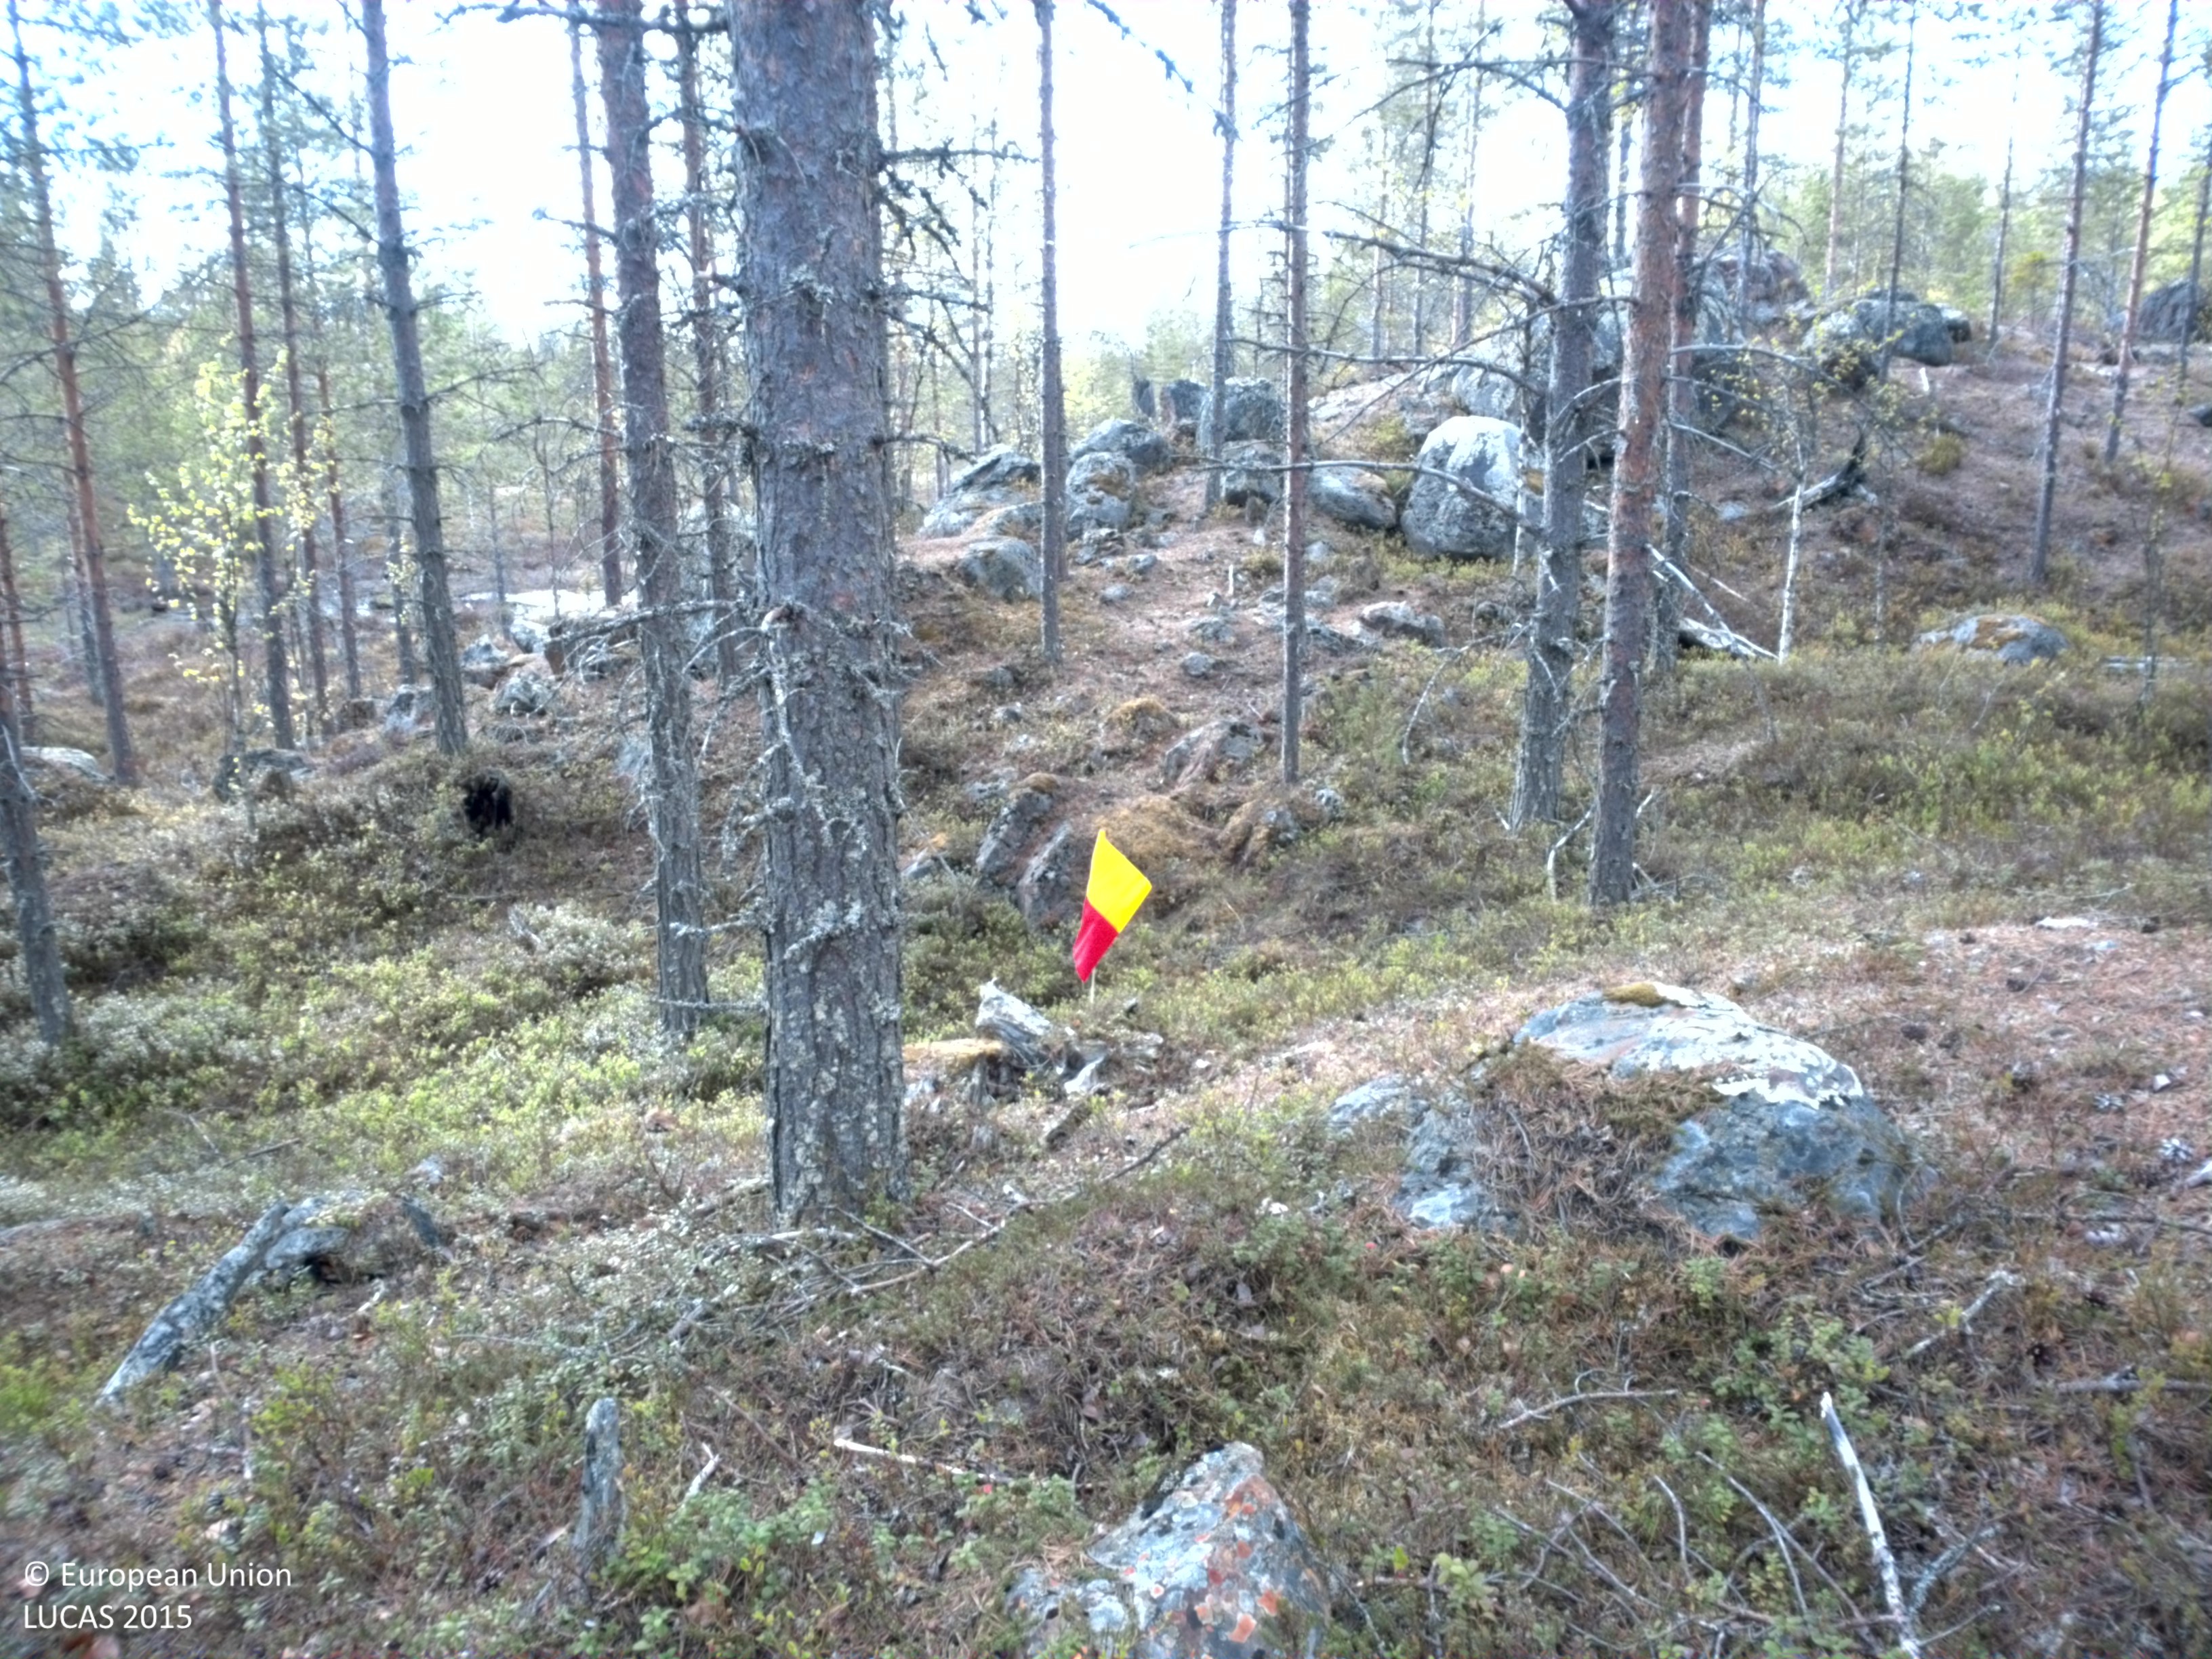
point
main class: Woodland
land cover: Pine dominated coniferous woodland
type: boreal forest
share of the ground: 25 - 50 %
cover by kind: shrubs 35 %, coniferous forest trees 30 %, unconsolidated bare surface 15 %, lichens and mosses 10 %, broadleaved forest trees 5 %, herbaceous plants 5 %
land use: Forestry
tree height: > 5 m
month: June
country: SE
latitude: 64.3607
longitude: 17.6114
